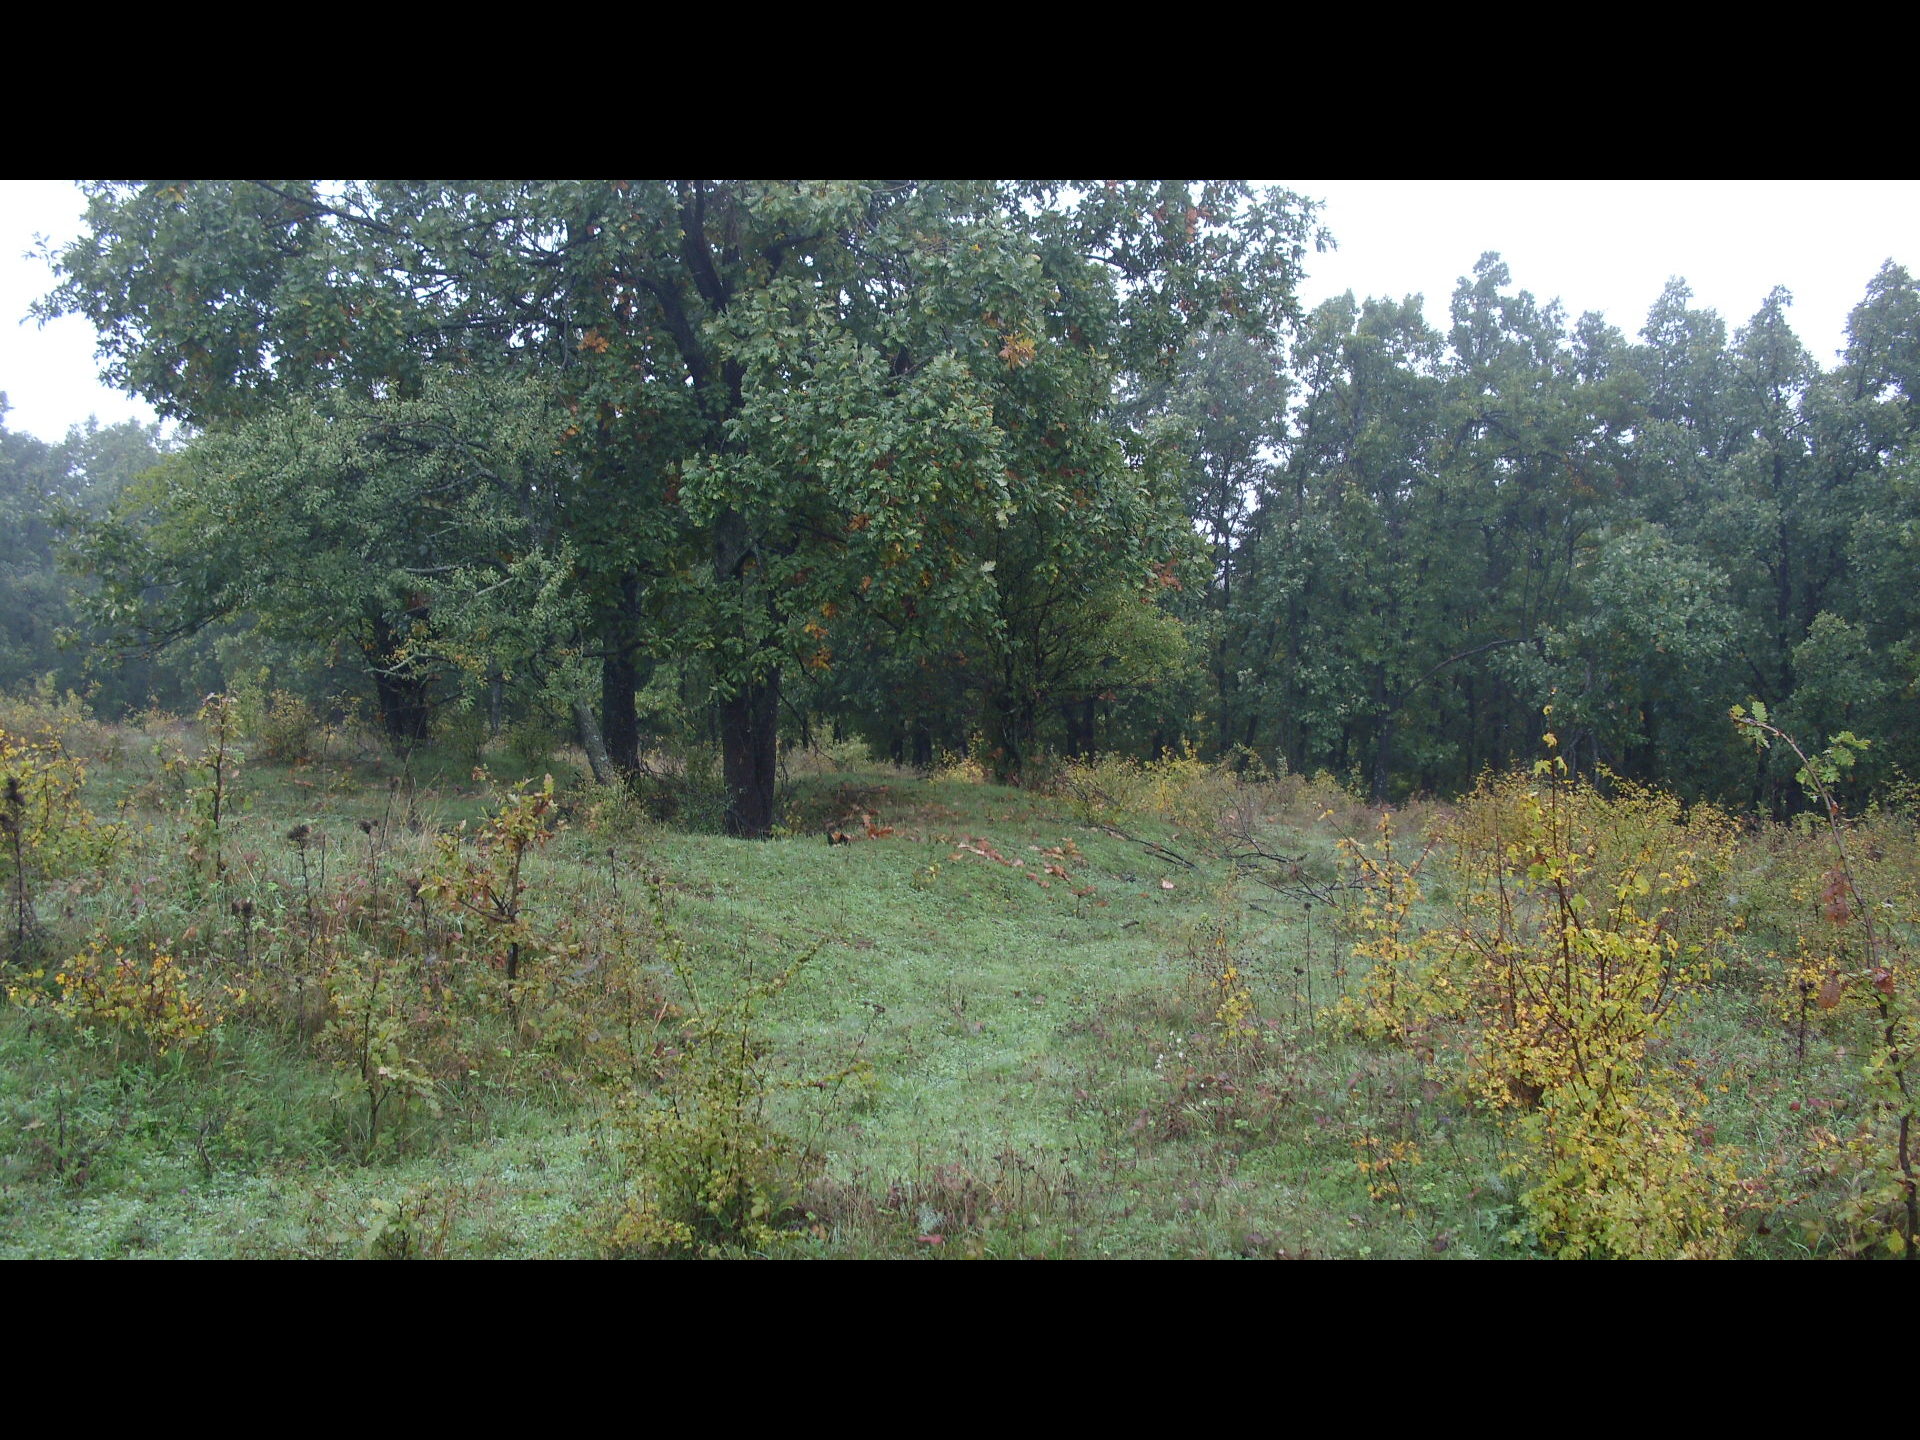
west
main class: Cropland
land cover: Other fruit trees and berries
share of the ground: < 10 %
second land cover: Grassland without tree/shrub cover
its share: > 75 %
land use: Agriculture (excluding fallow land and kitchen gardens)
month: October
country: BG
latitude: 43.7775
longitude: 22.4692
